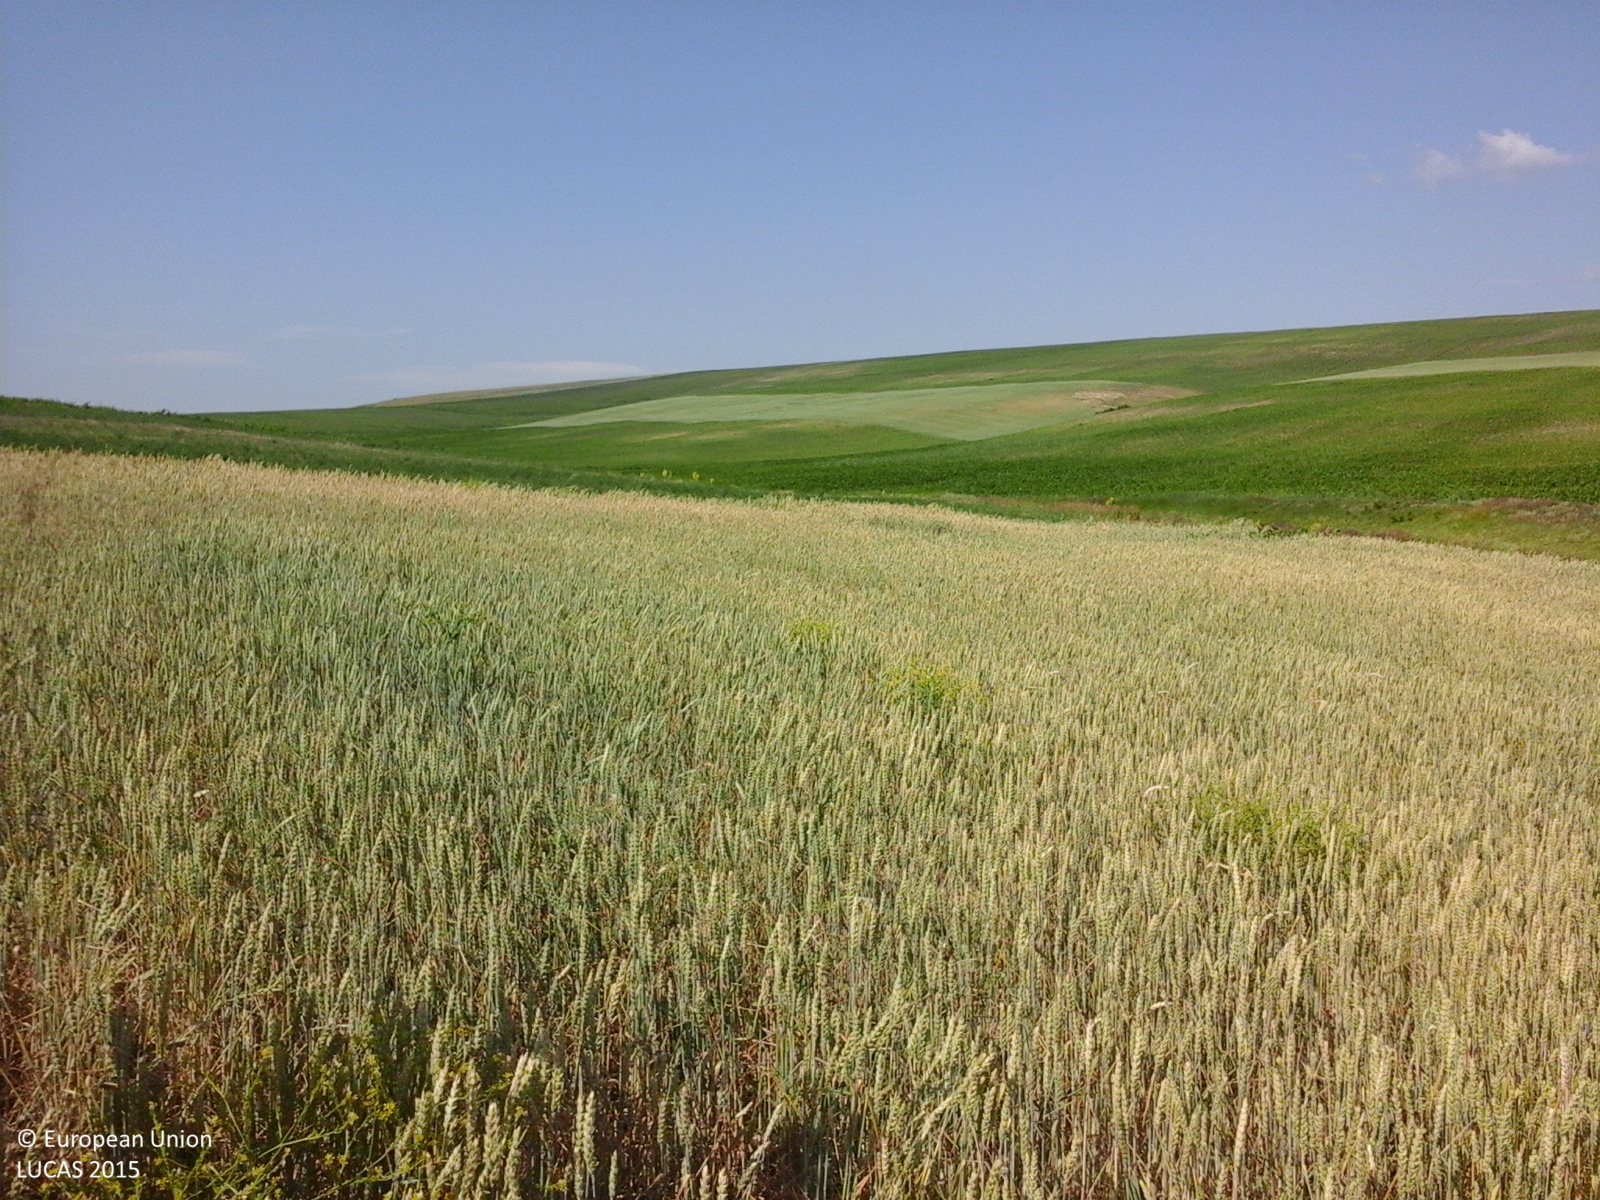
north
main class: Cropland
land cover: Common wheat
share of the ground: > 75 %
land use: Agriculture (excluding fallow land and kitchen gardens)
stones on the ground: < 10 %
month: June
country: RO
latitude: 46.8093
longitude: 27.7195
